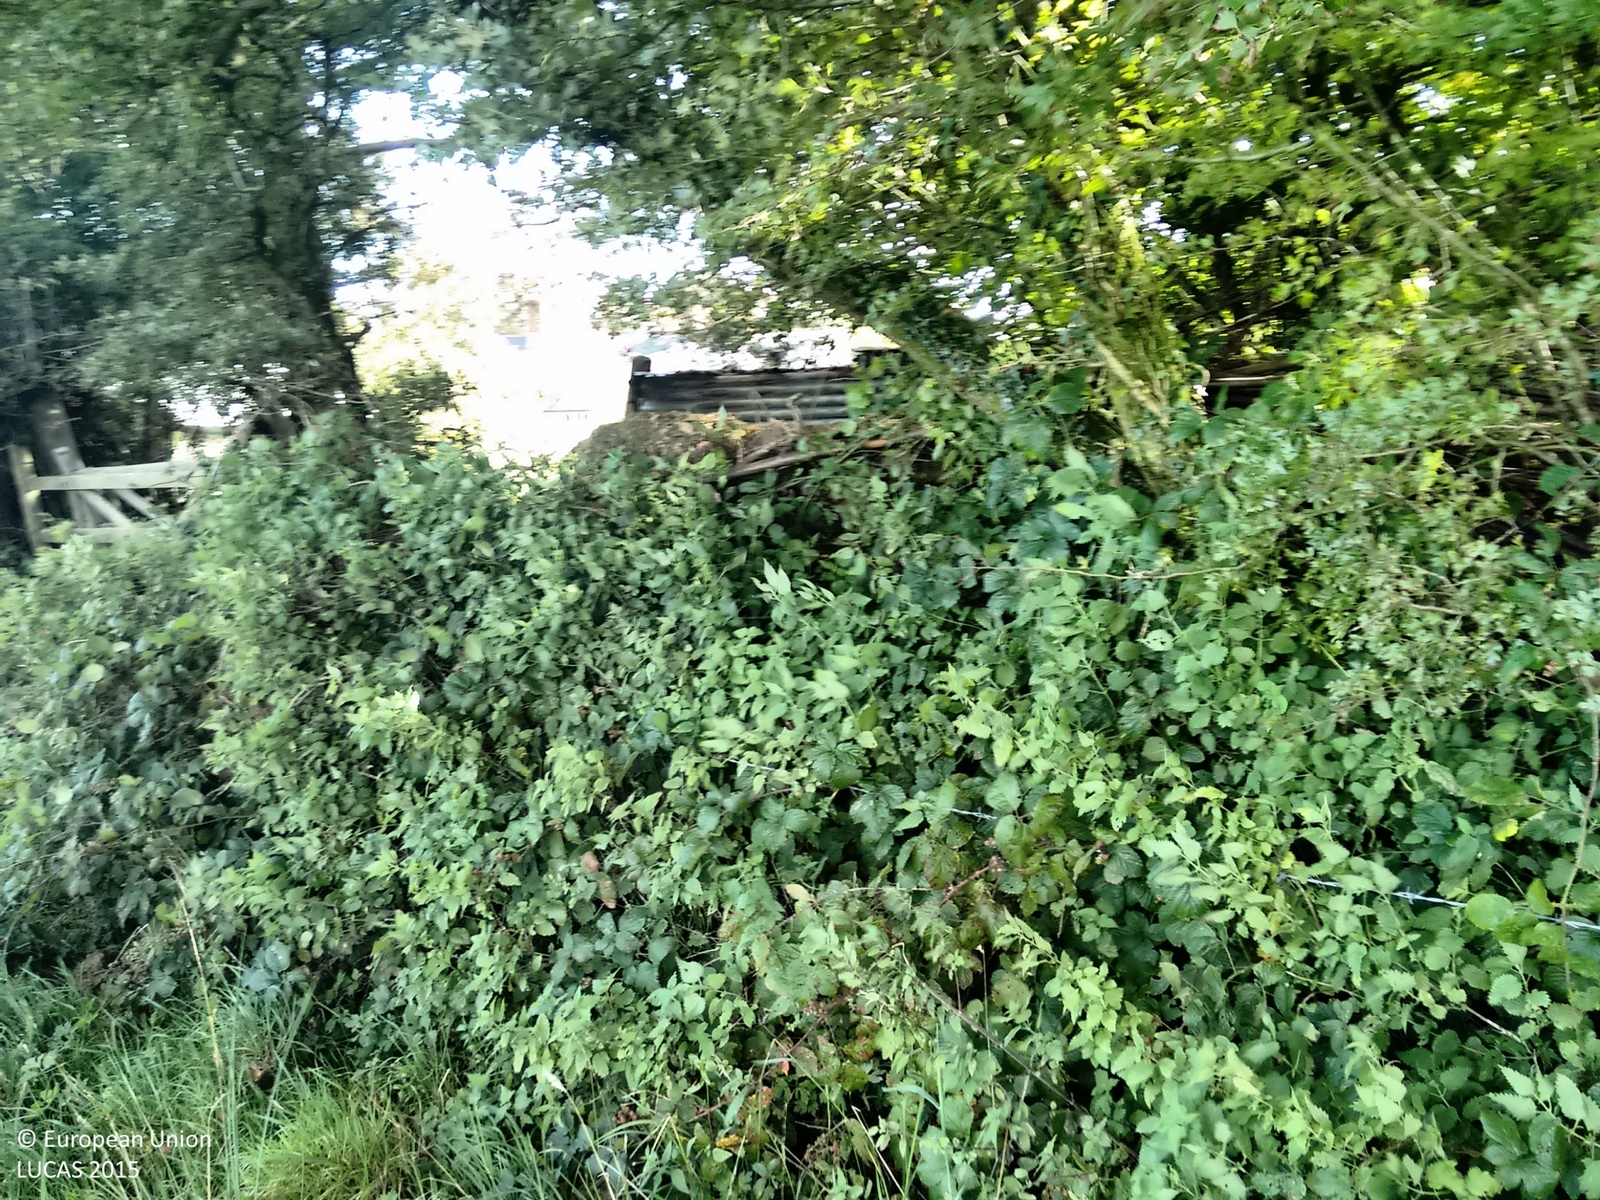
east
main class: Grassland
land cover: Grassland without tree/shrub cover
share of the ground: > 75 %
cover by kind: herbaceous plants 100 %
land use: Agriculture (excluding fallow land and kitchen gardens)
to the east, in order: Grassland without tree/shrub cover; Fences; Broadleaved woodland; Artificial constructions in urban areas; Managed hedges; Grassland without tree/shrub cover; Fences; Broadleaved woodland
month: September
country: GB
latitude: 50.7682
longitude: -4.2064
